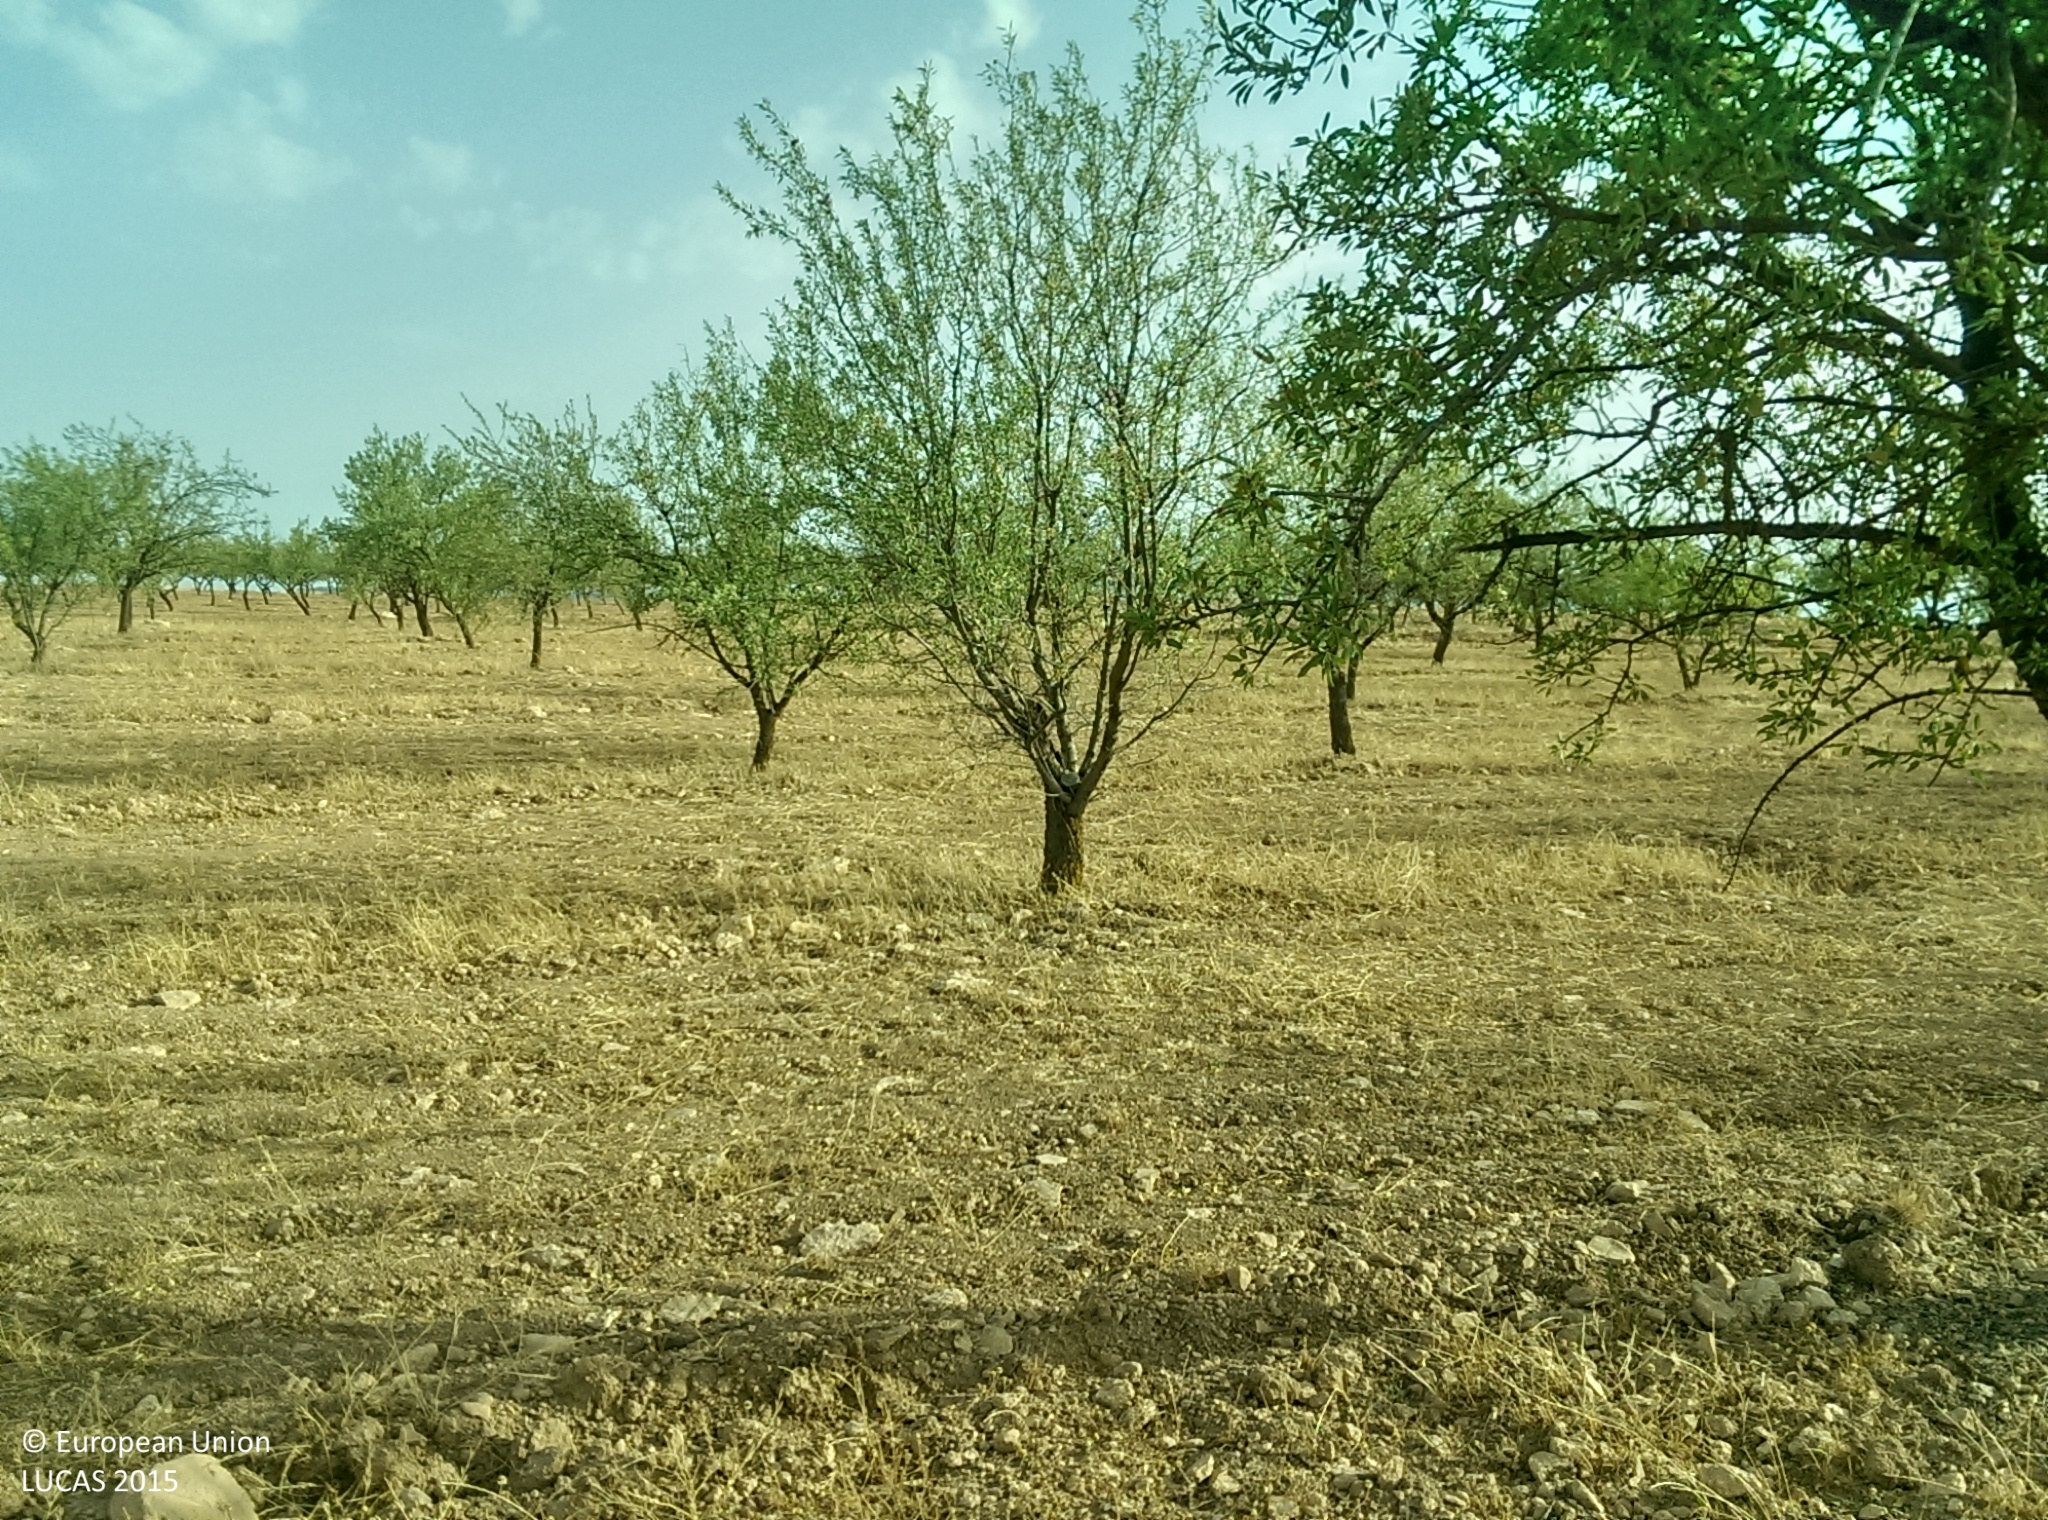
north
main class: Cropland
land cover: Nuts trees
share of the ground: 25 - 50 %
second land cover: Other bare soil
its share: > 75 %
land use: Agriculture (excluding fallow land and kitchen gardens)
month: July
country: ES
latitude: 37.6085
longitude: -2.9608
